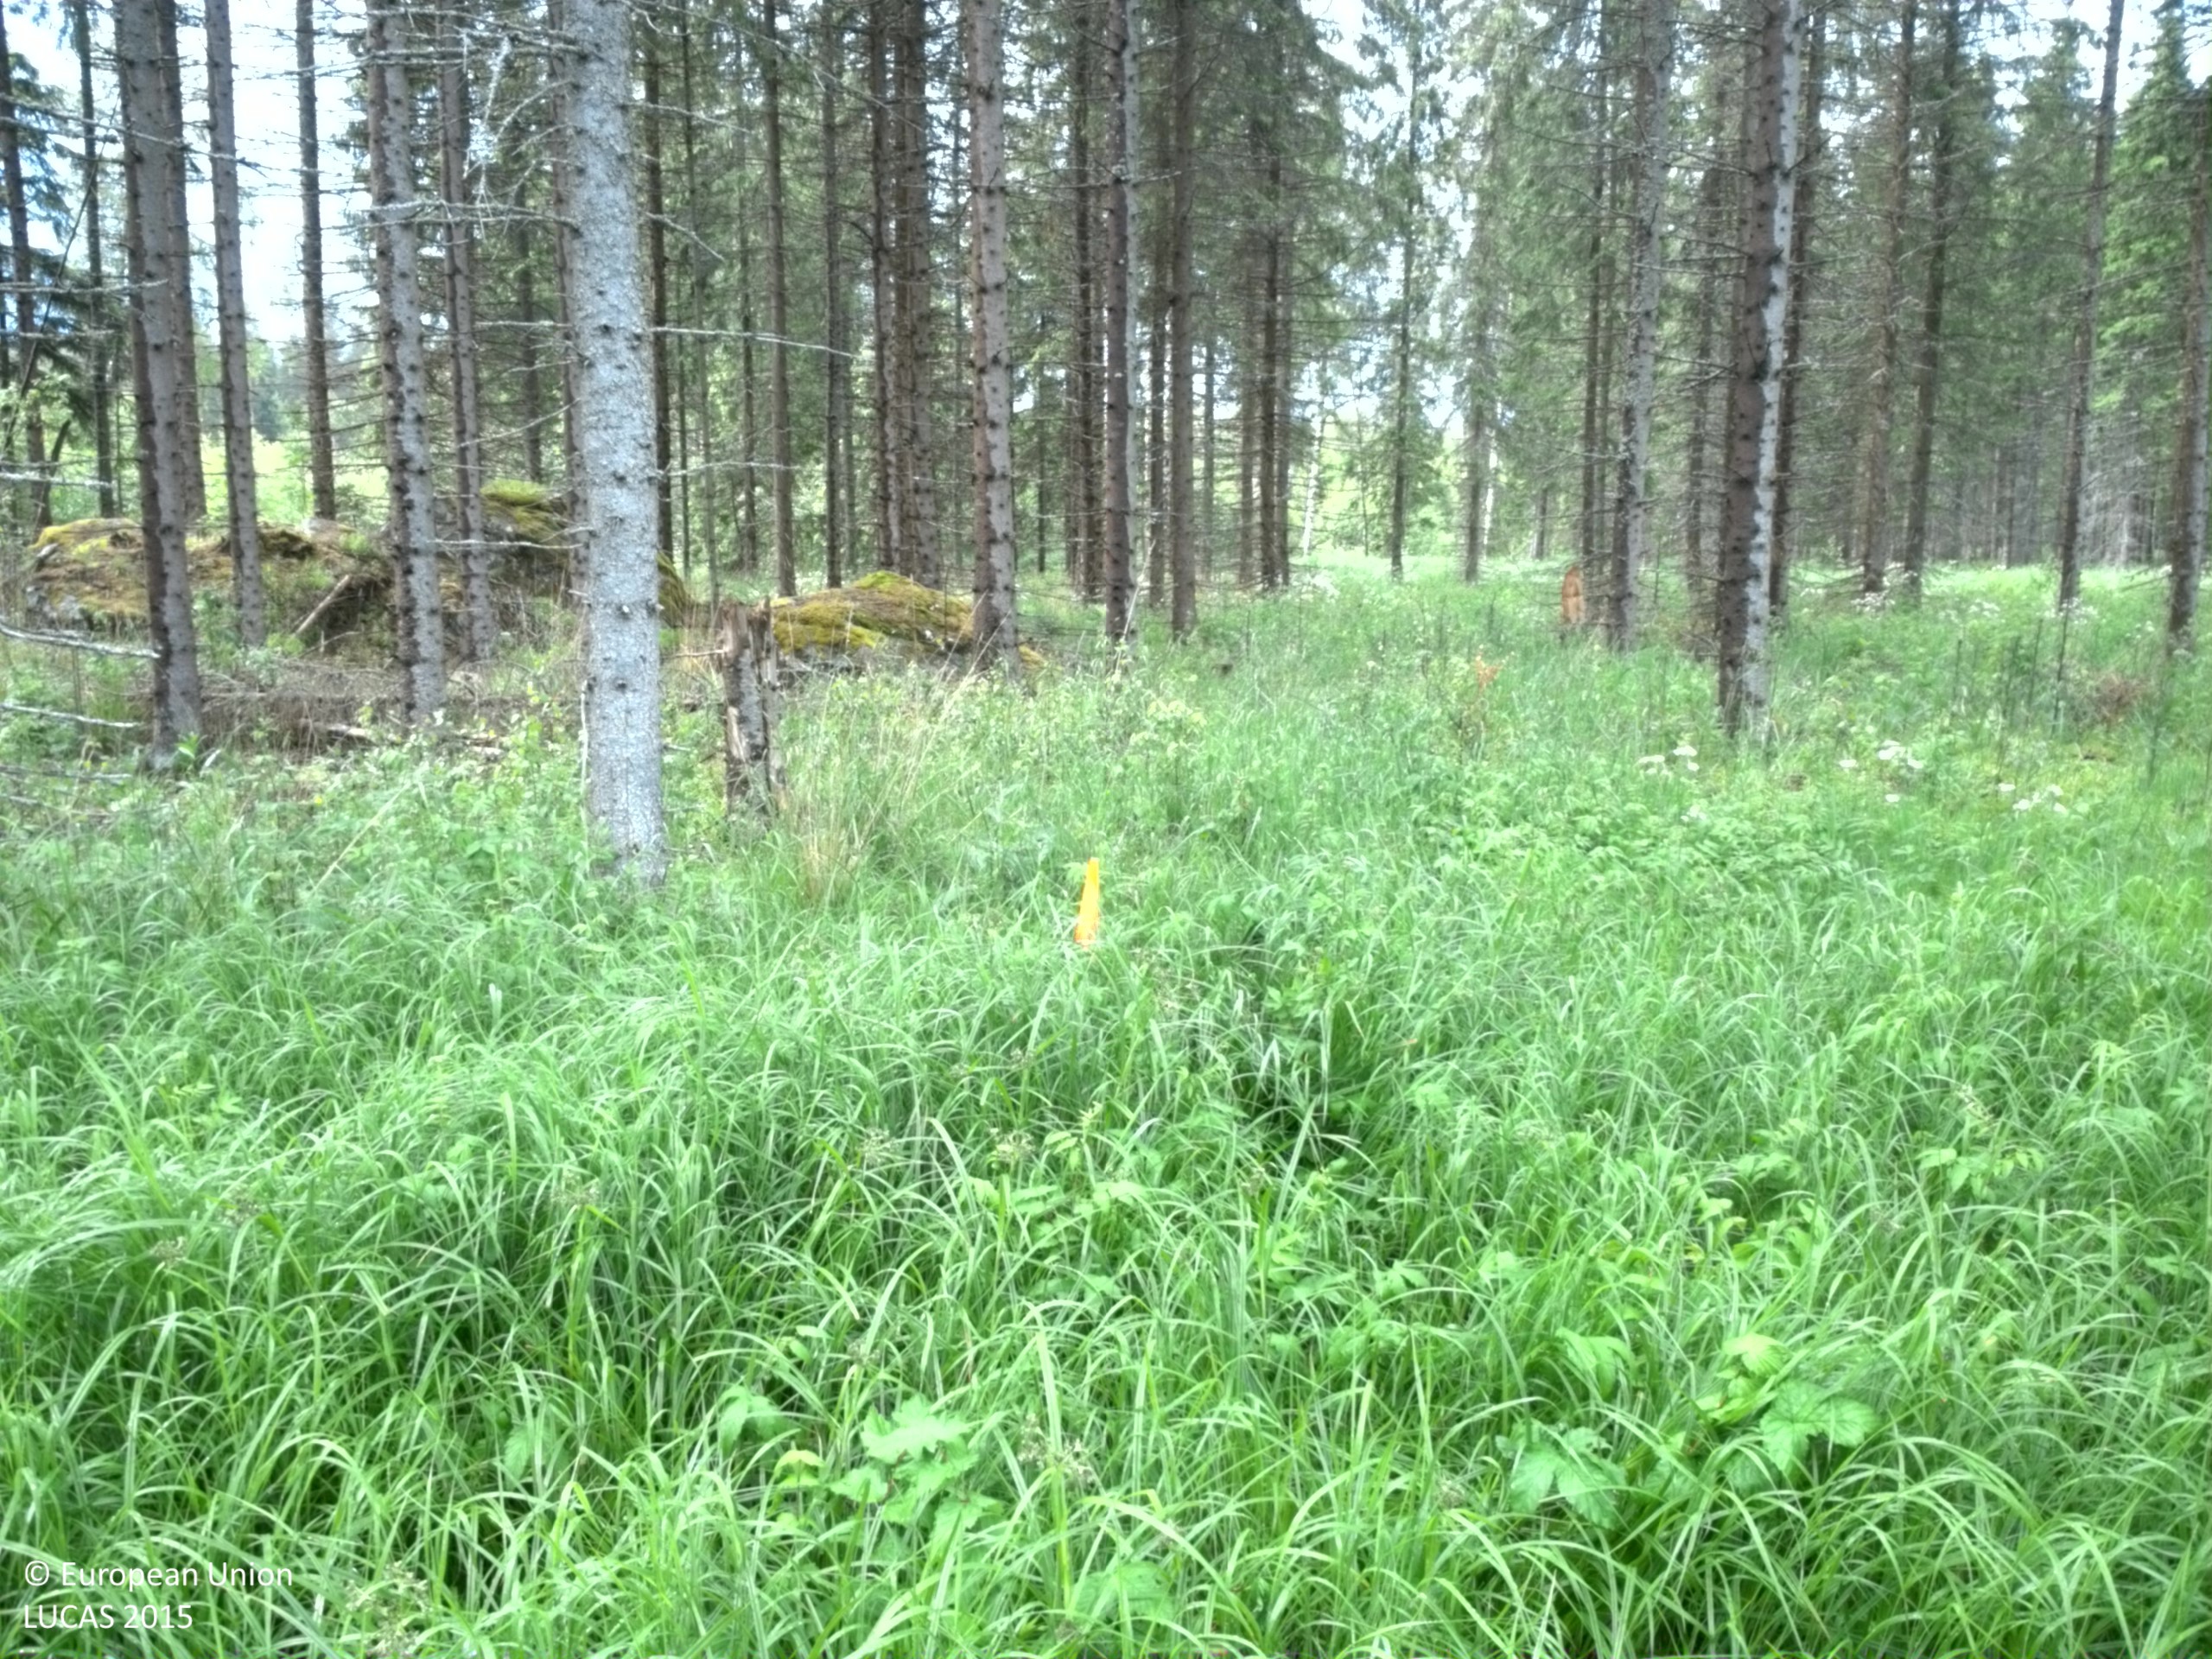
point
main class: Woodland
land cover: Spruce dominated coniferous woodland
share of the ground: 25 - 50 %
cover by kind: herbaceous plants 50 %, coniferous forest trees 40 %, lichens and mosses 5 %, consolidated bare surface 5 %
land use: Forestry
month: June
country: SE
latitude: 60.3307
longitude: 17.7260
